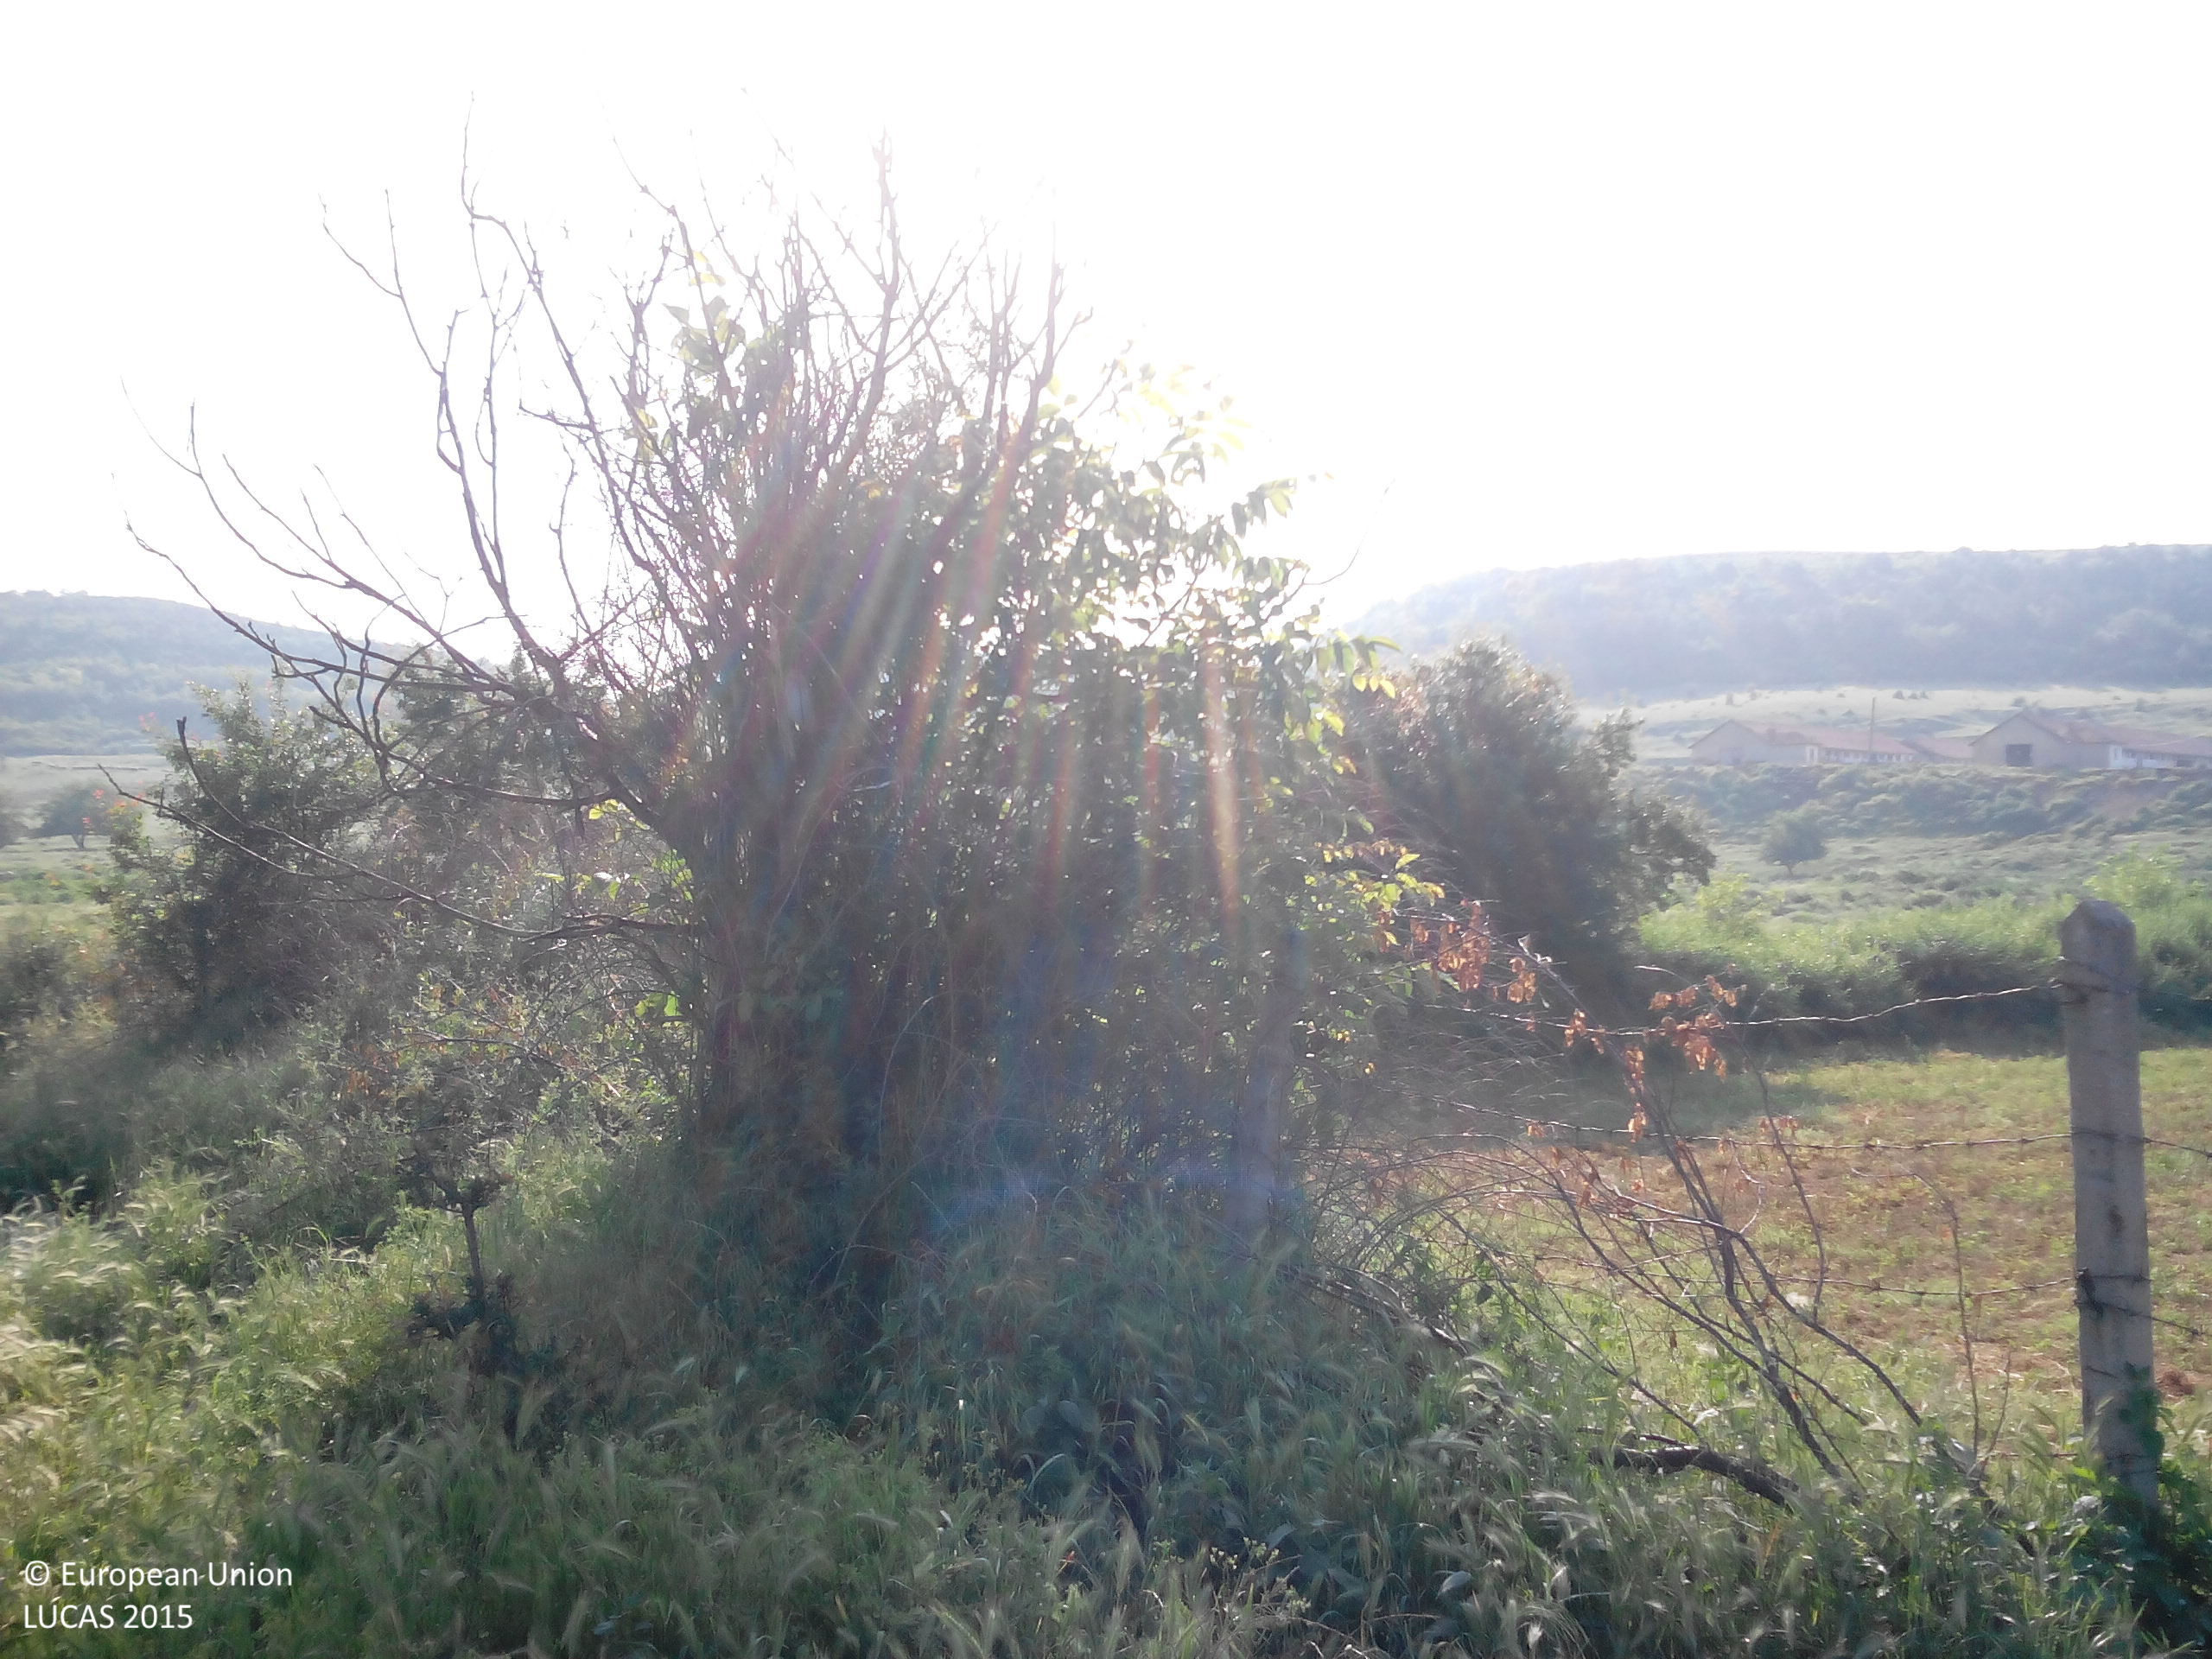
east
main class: Cropland
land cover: Lucerne
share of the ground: > 75 %
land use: Agriculture (excluding fallow land and kitchen gardens)
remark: Harvested field
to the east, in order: Lucerne; Shrubland with sparse tree cover; Fences; Tracks; Shrubland without tree cover; Tracks; Shrubland without tree cover; Grassland without tree/shrub cover; Shruby margins; Tracks; Grassland without tree/shrub cover
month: May
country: BG
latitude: 43.5972
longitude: 24.3928
